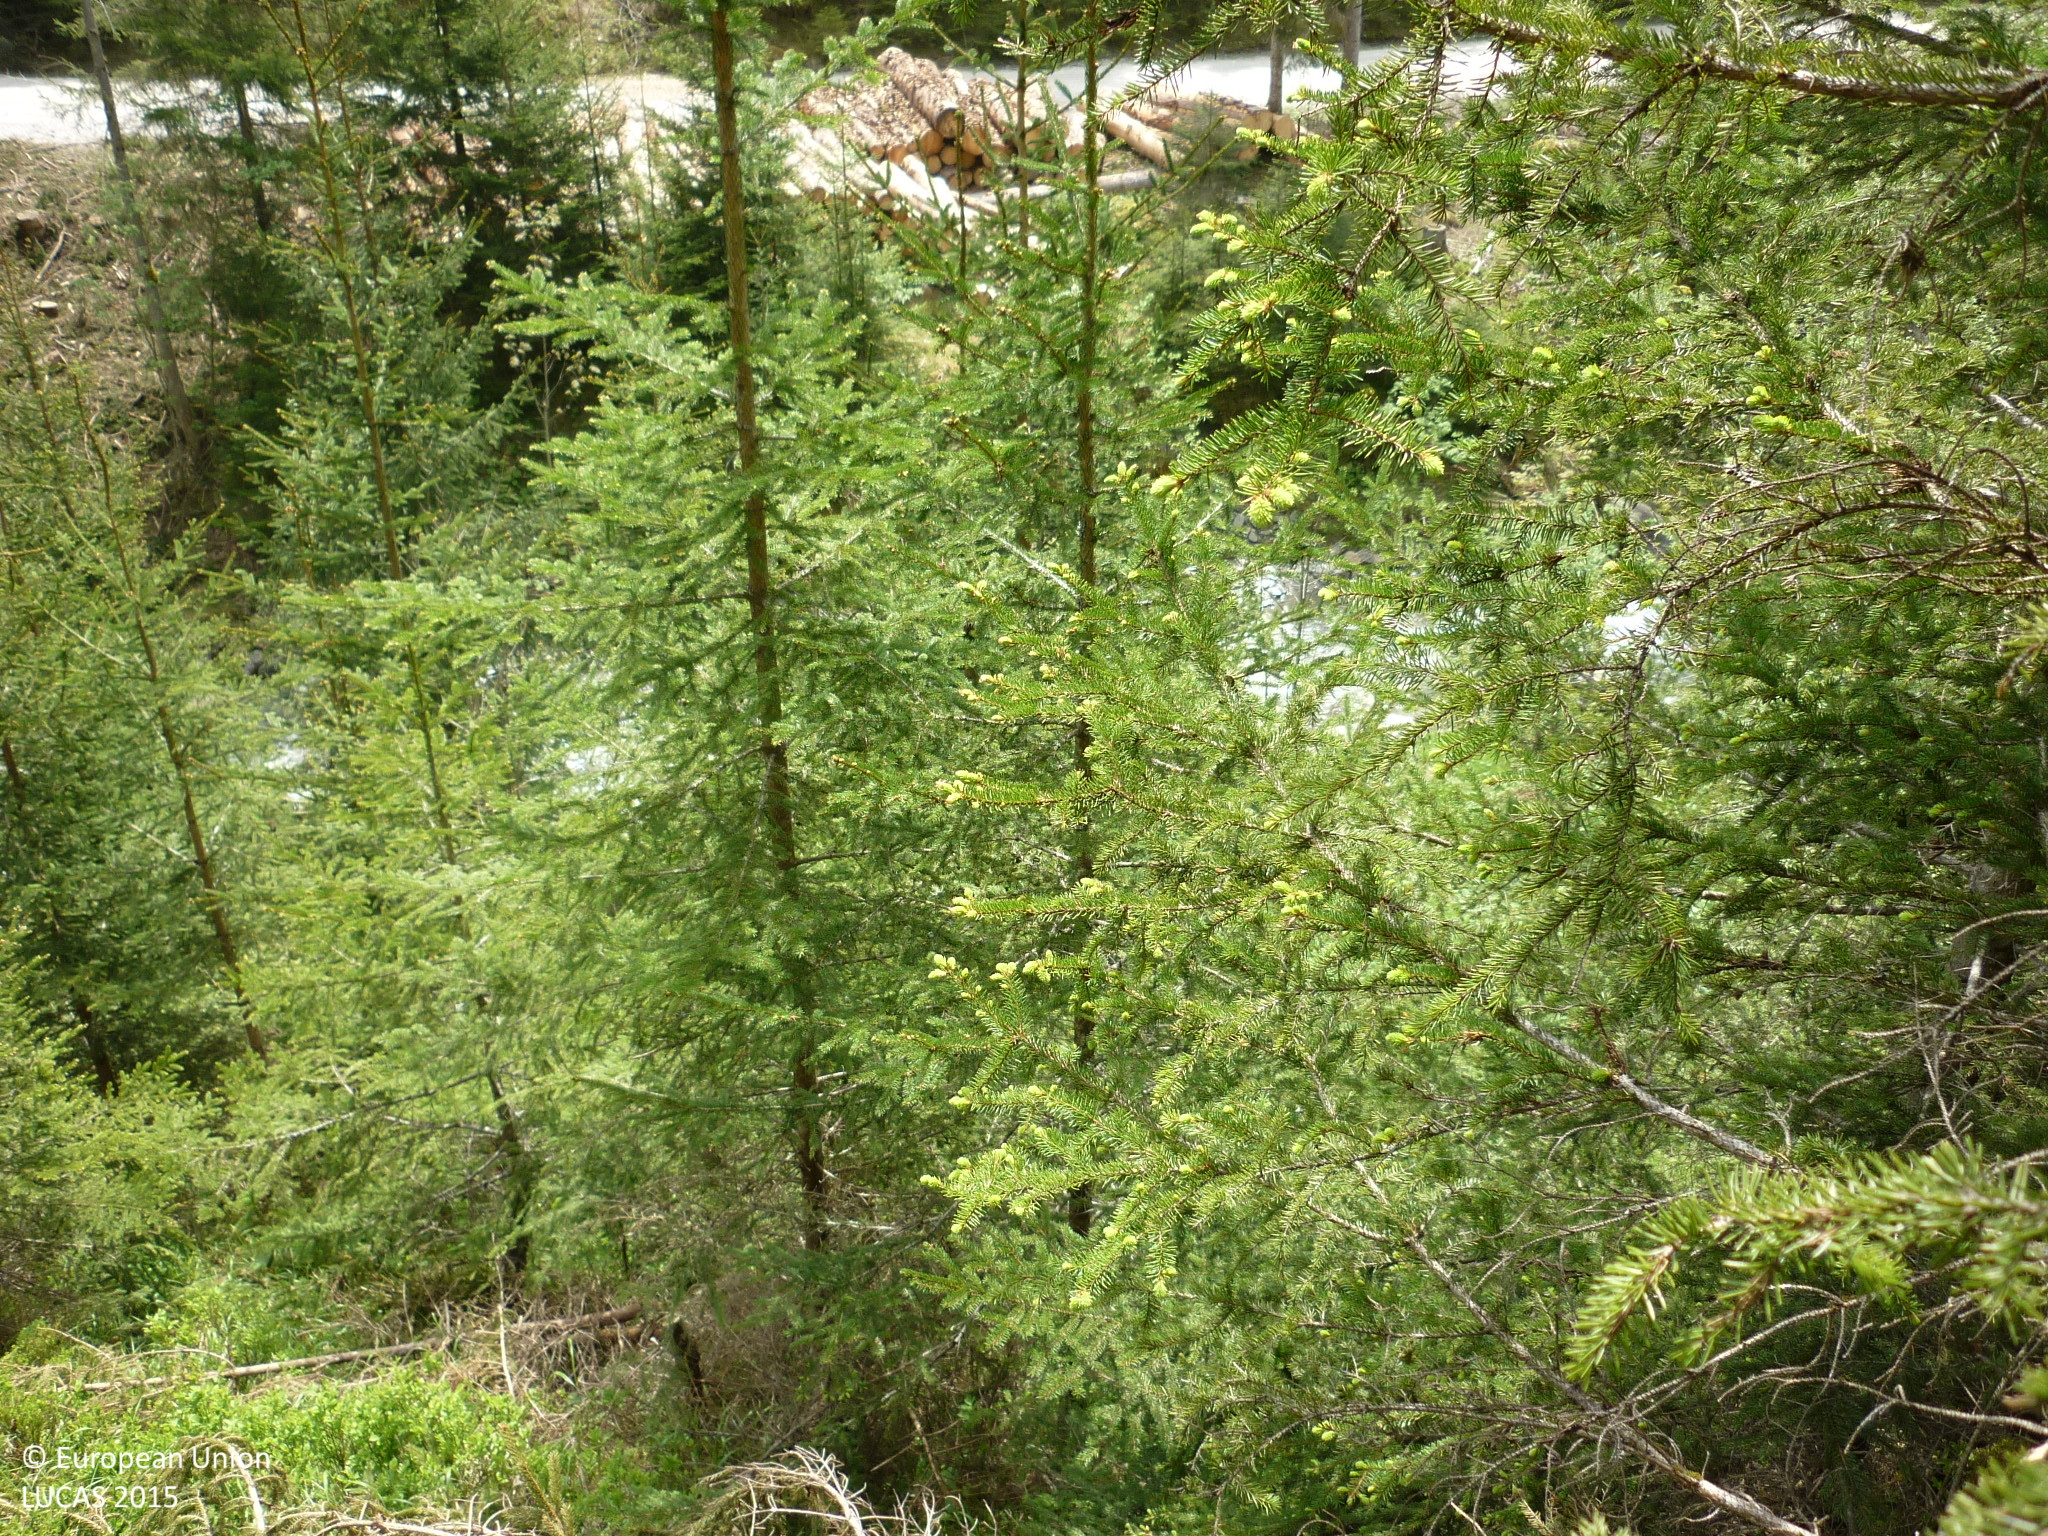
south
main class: Woodland
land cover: Spruce dominated coniferous woodland
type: alpine coniferous forest
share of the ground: > 75 %
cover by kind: coniferous forest trees 75 %, broadleaved forest trees 20 %, herbaceous plants 5 %
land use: Forestry
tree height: > 5 m
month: May
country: AT
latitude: 47.4287
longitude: 14.0421
